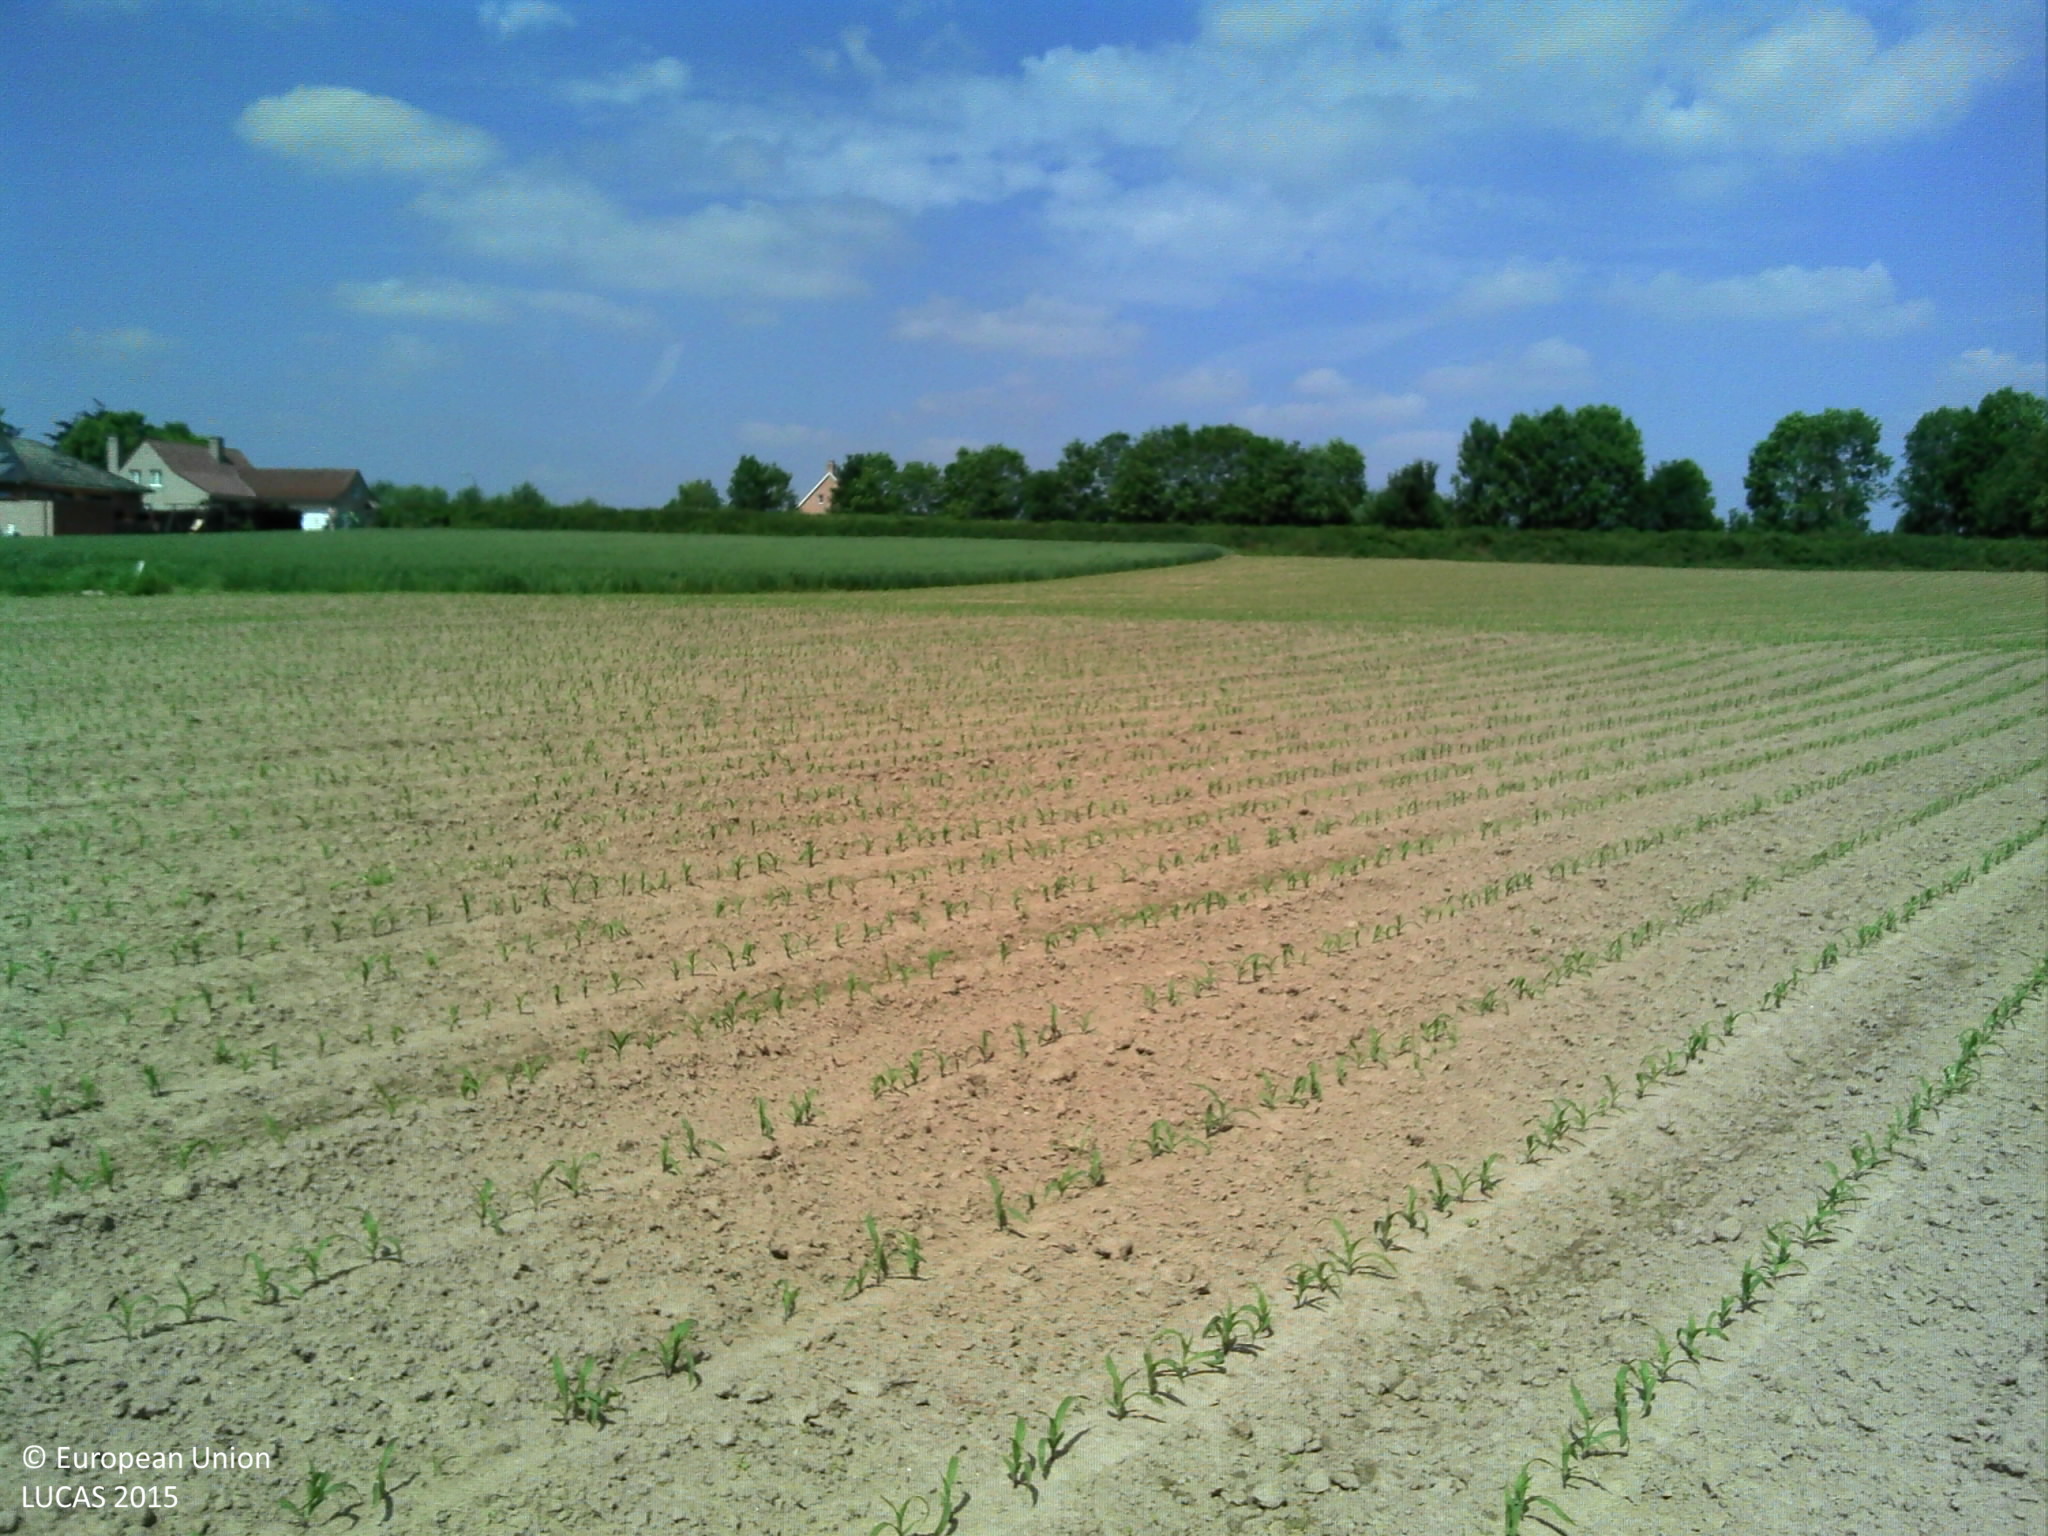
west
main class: Cropland
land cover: Maize
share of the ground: < 10 %
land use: Agriculture (excluding fallow land and kitchen gardens)
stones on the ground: < 10 %
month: June
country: BE
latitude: 50.9370
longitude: 3.8318
